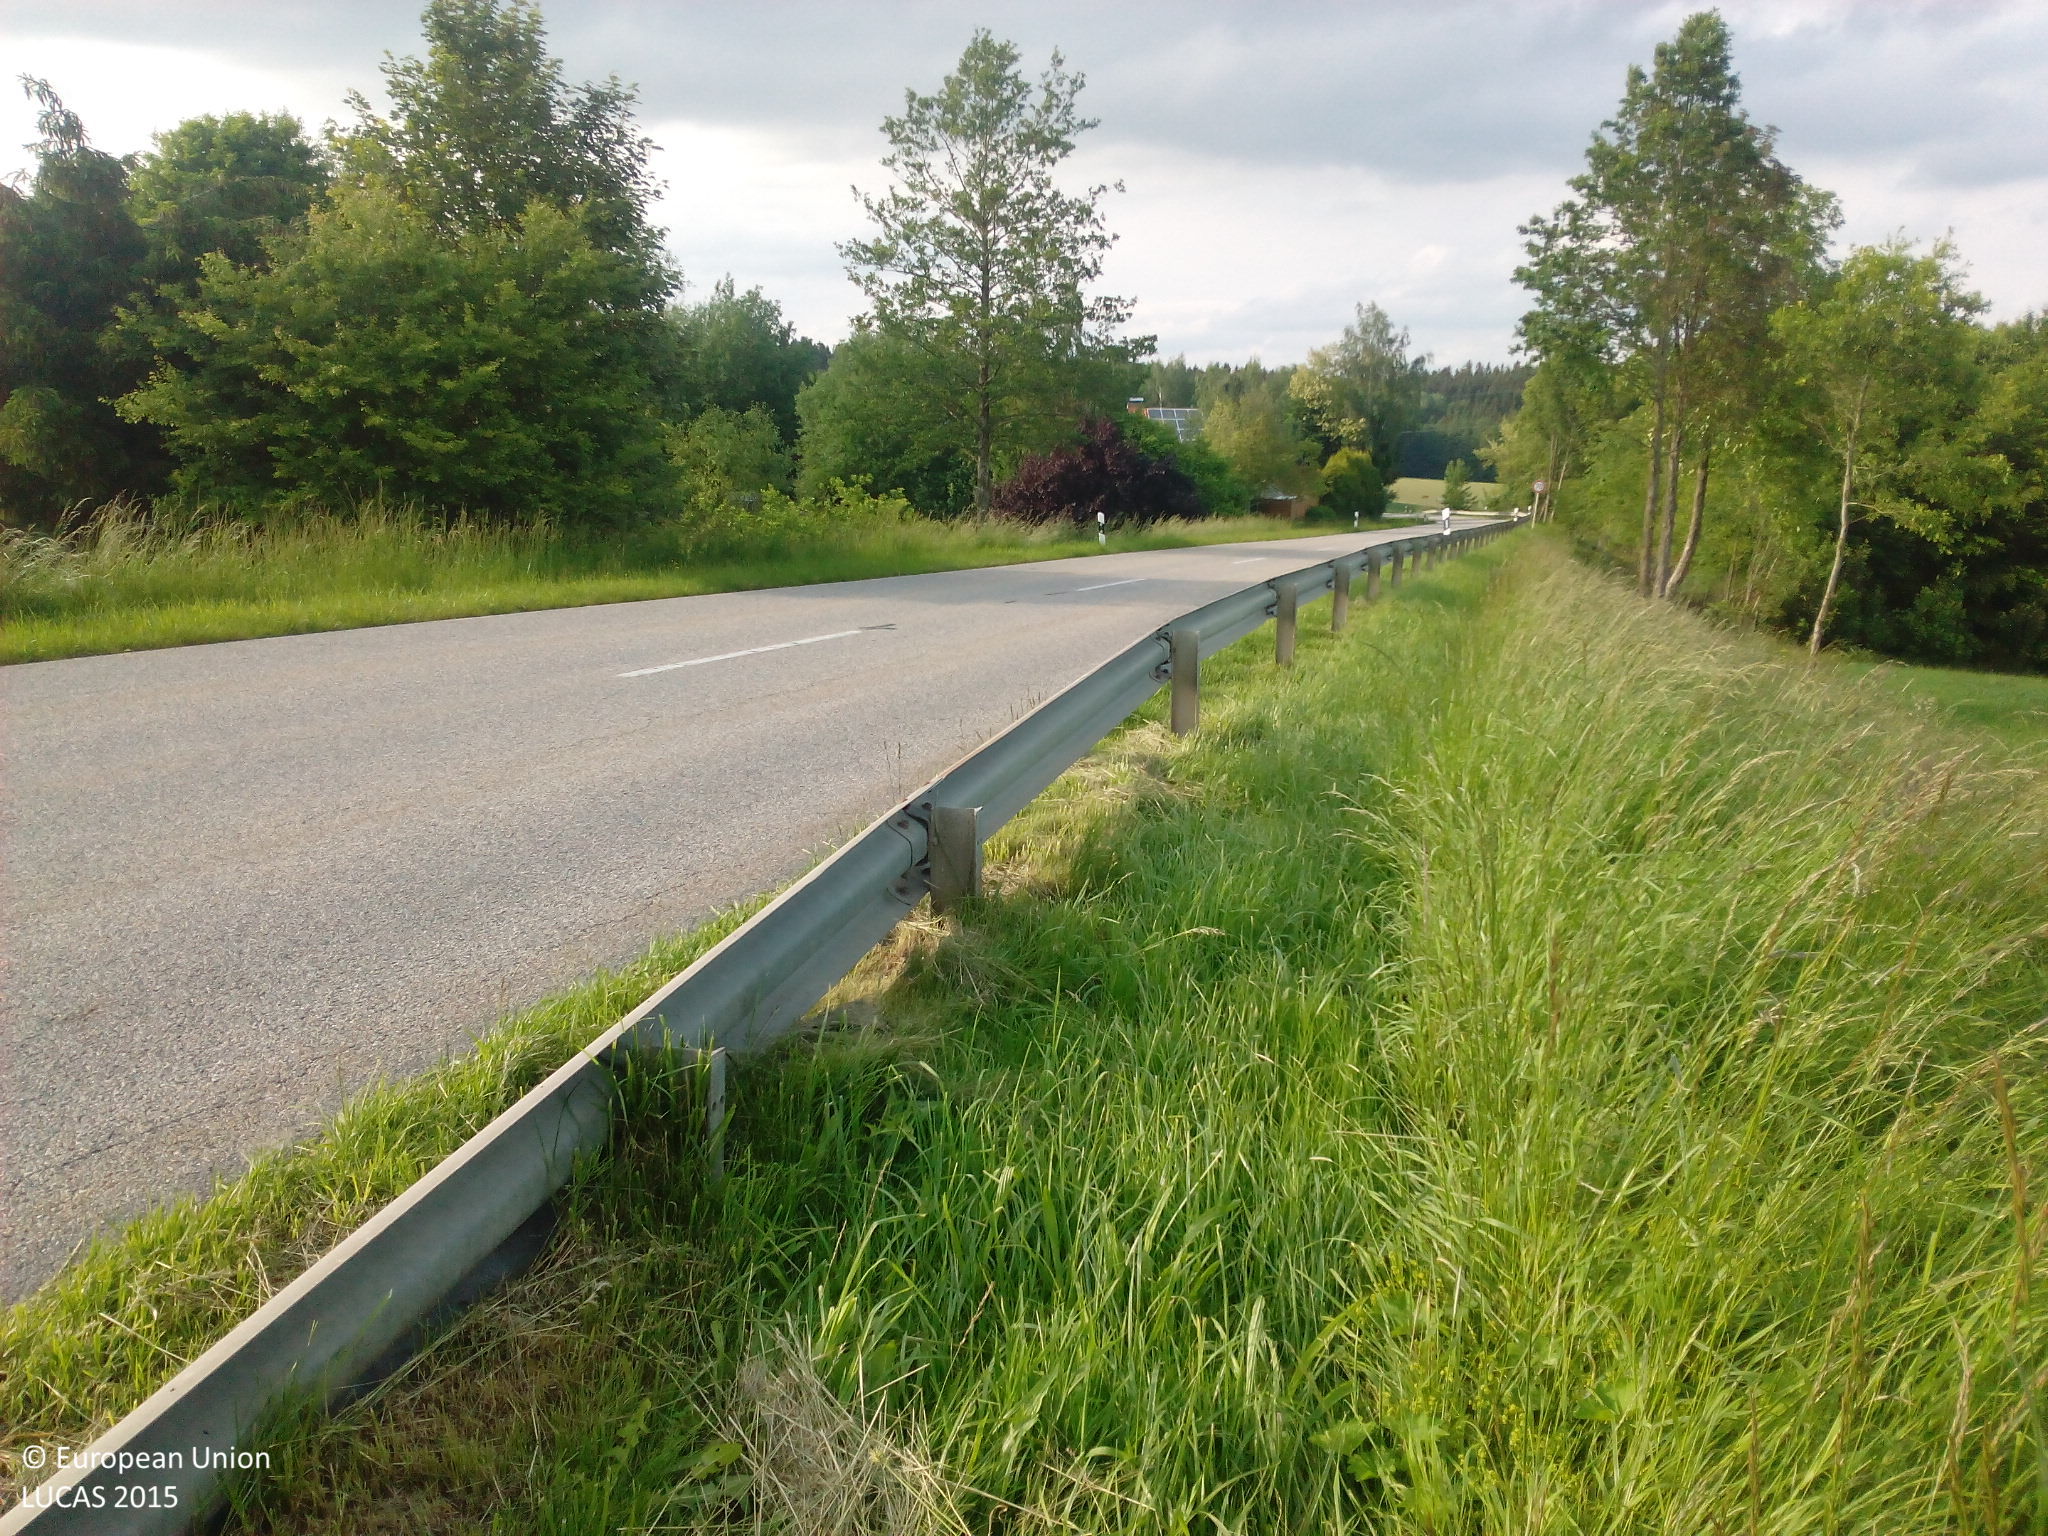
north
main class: Grassland
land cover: Grassland without tree/shrub cover
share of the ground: > 75 %
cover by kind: herbaceous plants 100 %
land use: Road transport
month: May
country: DE
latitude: 48.3597
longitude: 12.3879
